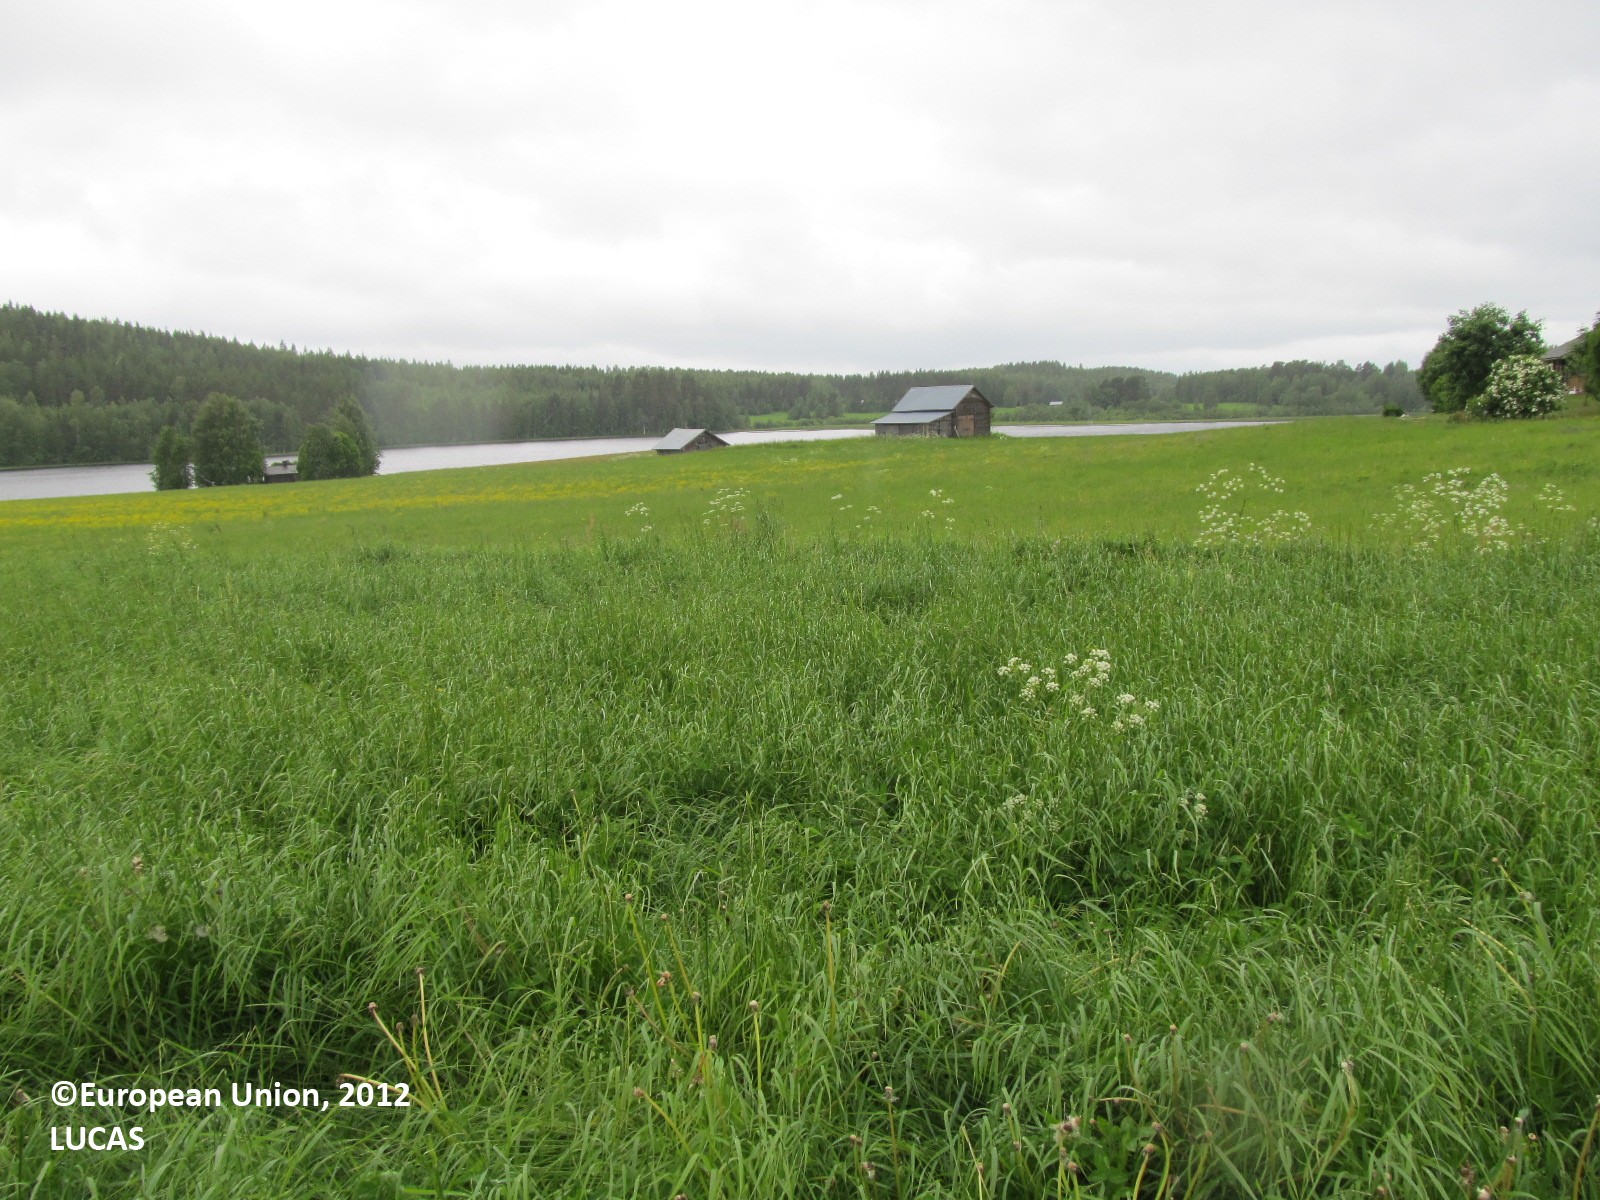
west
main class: Grassland
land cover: Grassland without tree/shrub cover
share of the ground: 50 - 75 %
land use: Fallow land
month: June
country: FI
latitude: 62.7713
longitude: 28.8006
